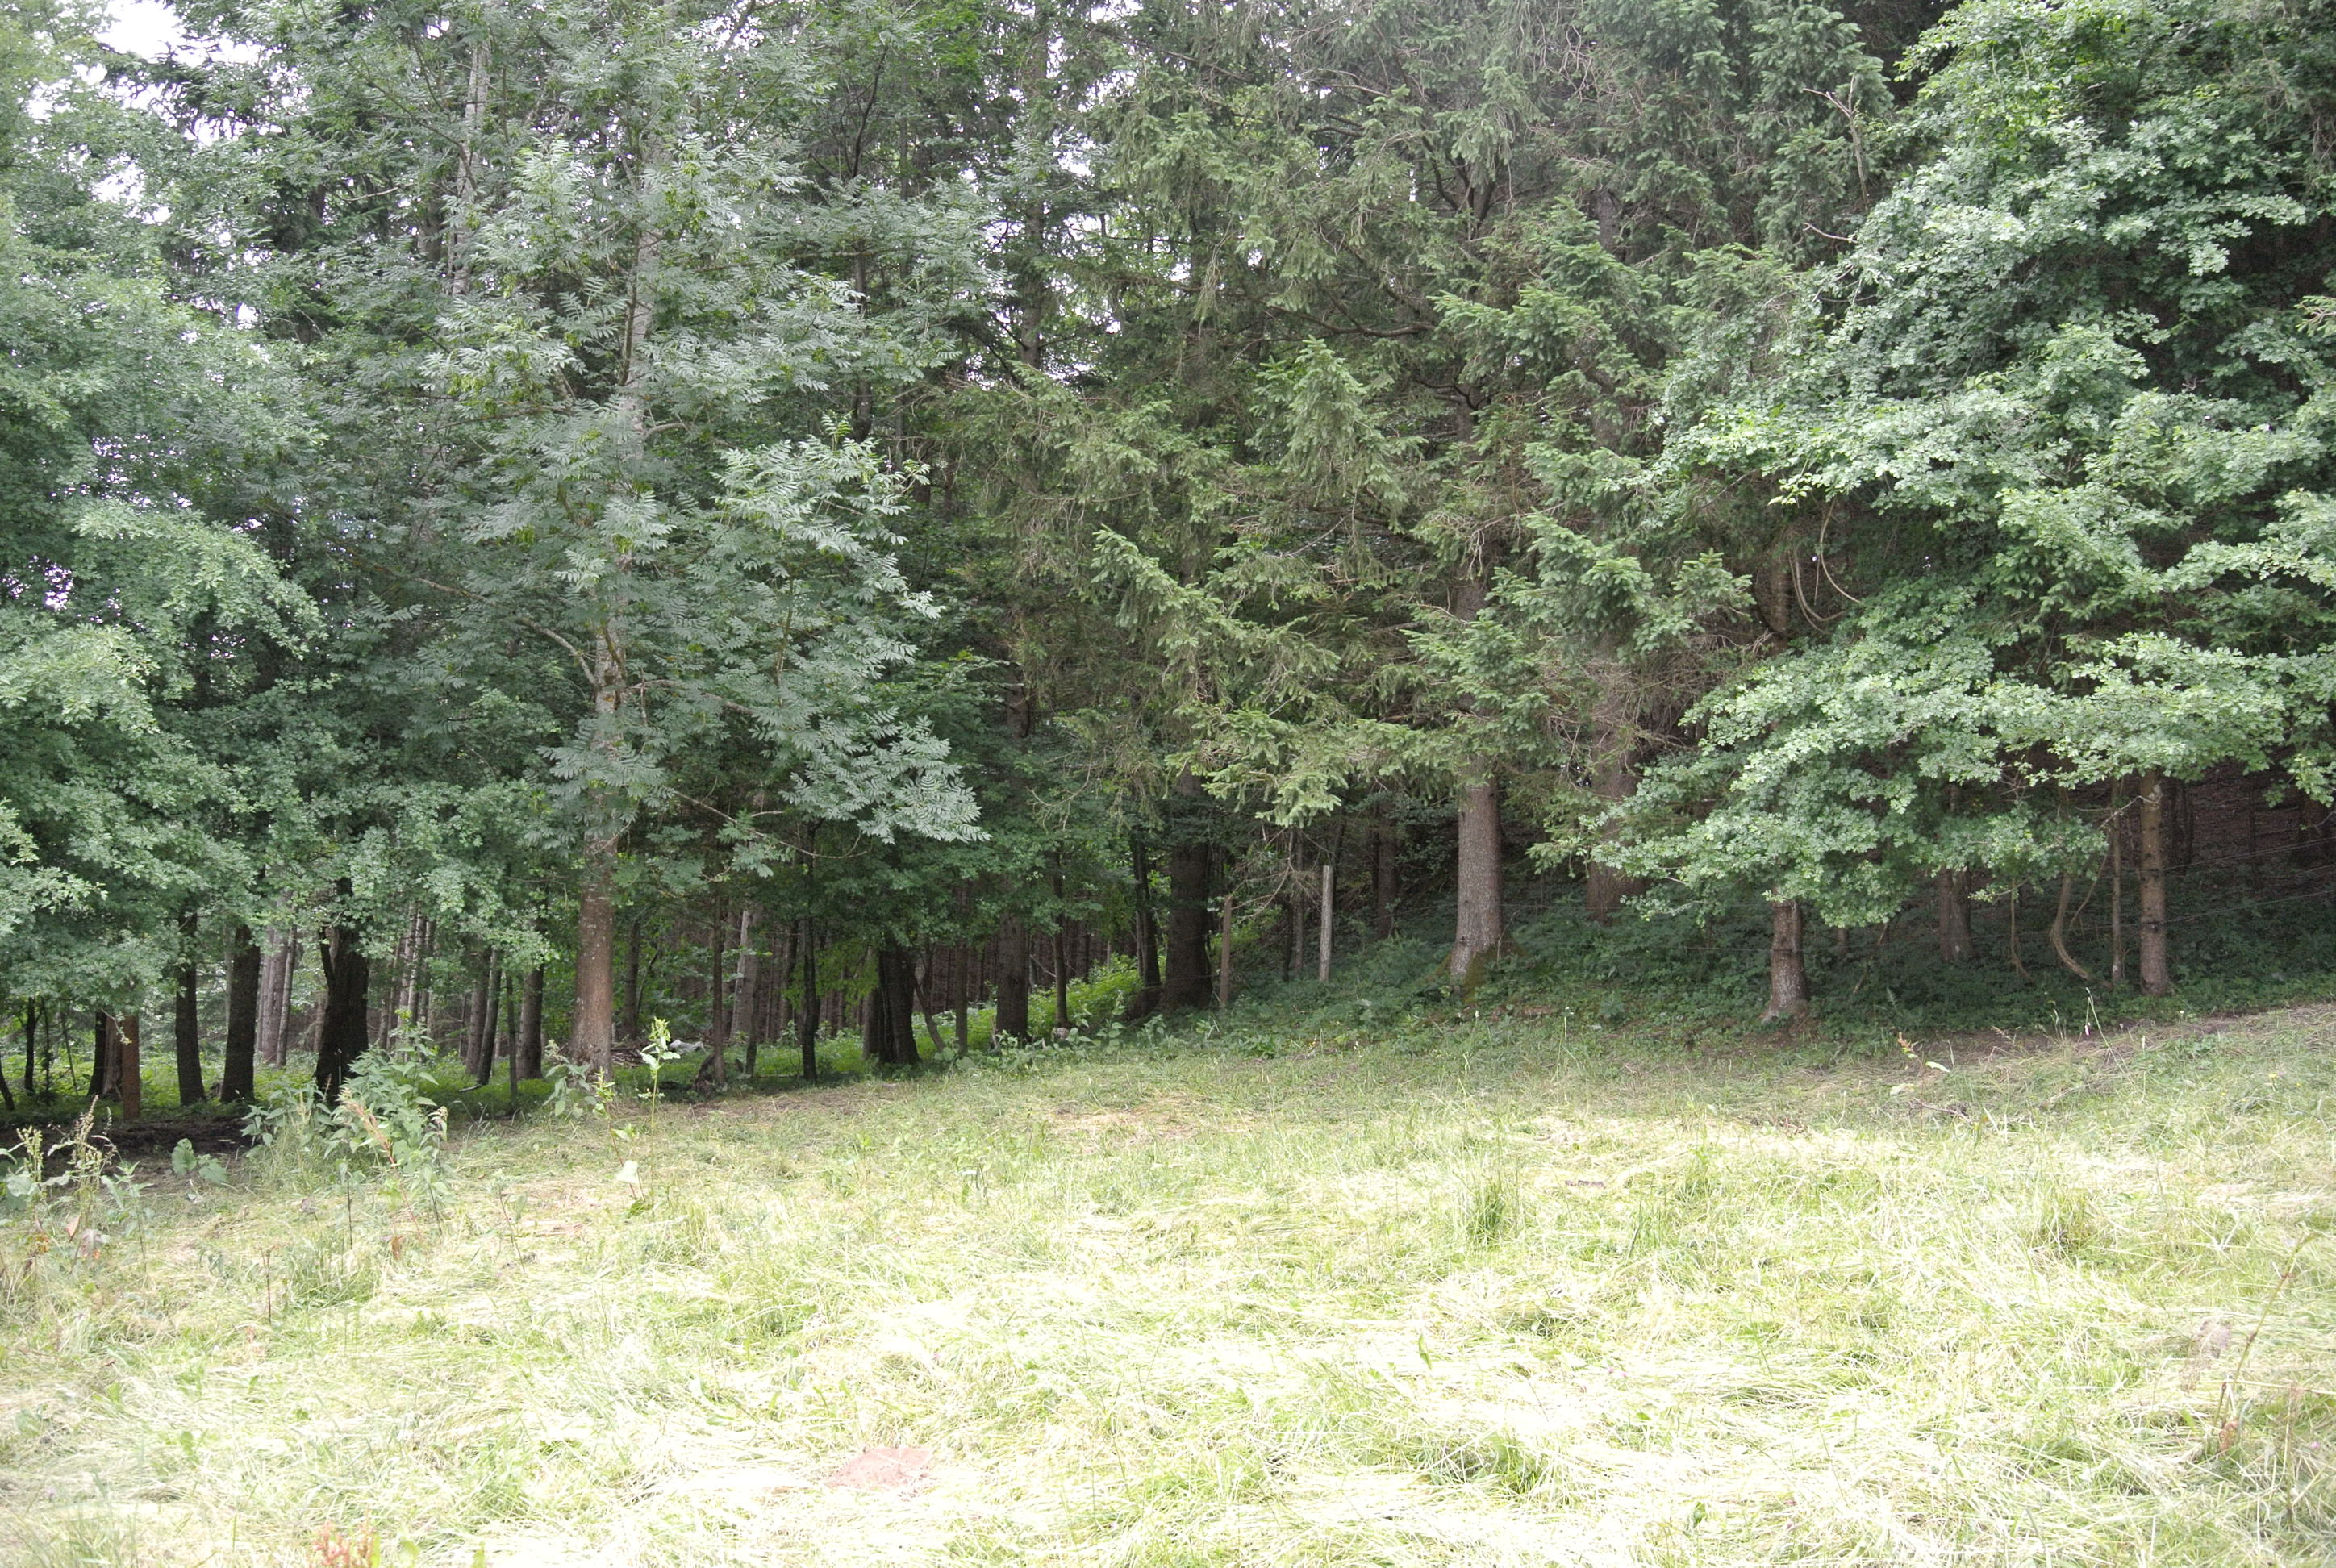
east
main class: Grassland
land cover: Grassland without tree/shrub cover
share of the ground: > 75 %
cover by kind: herbaceous plants 100 %
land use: Agriculture (excluding fallow land and kitchen gardens)
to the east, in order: Grassland without tree/shrub cover; Fences; Spruce dominated coniferous woodland; Spruce dominated mixed woodland; Tracks; Spruce dominated coniferous woodland; Fences; Spruce dominated coniferous woodland; Grassland without tree/shrub cover; Paved roads, cycling and walking lanes; Spontaneously vegetated surfaces; Paved roads, cycling and walking lanes; Grassland without tree/shrub cover; Artificial constructions in urban areas; Spruce dominated mixed woodland
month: June
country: AT
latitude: 47.8480
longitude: 15.5744
